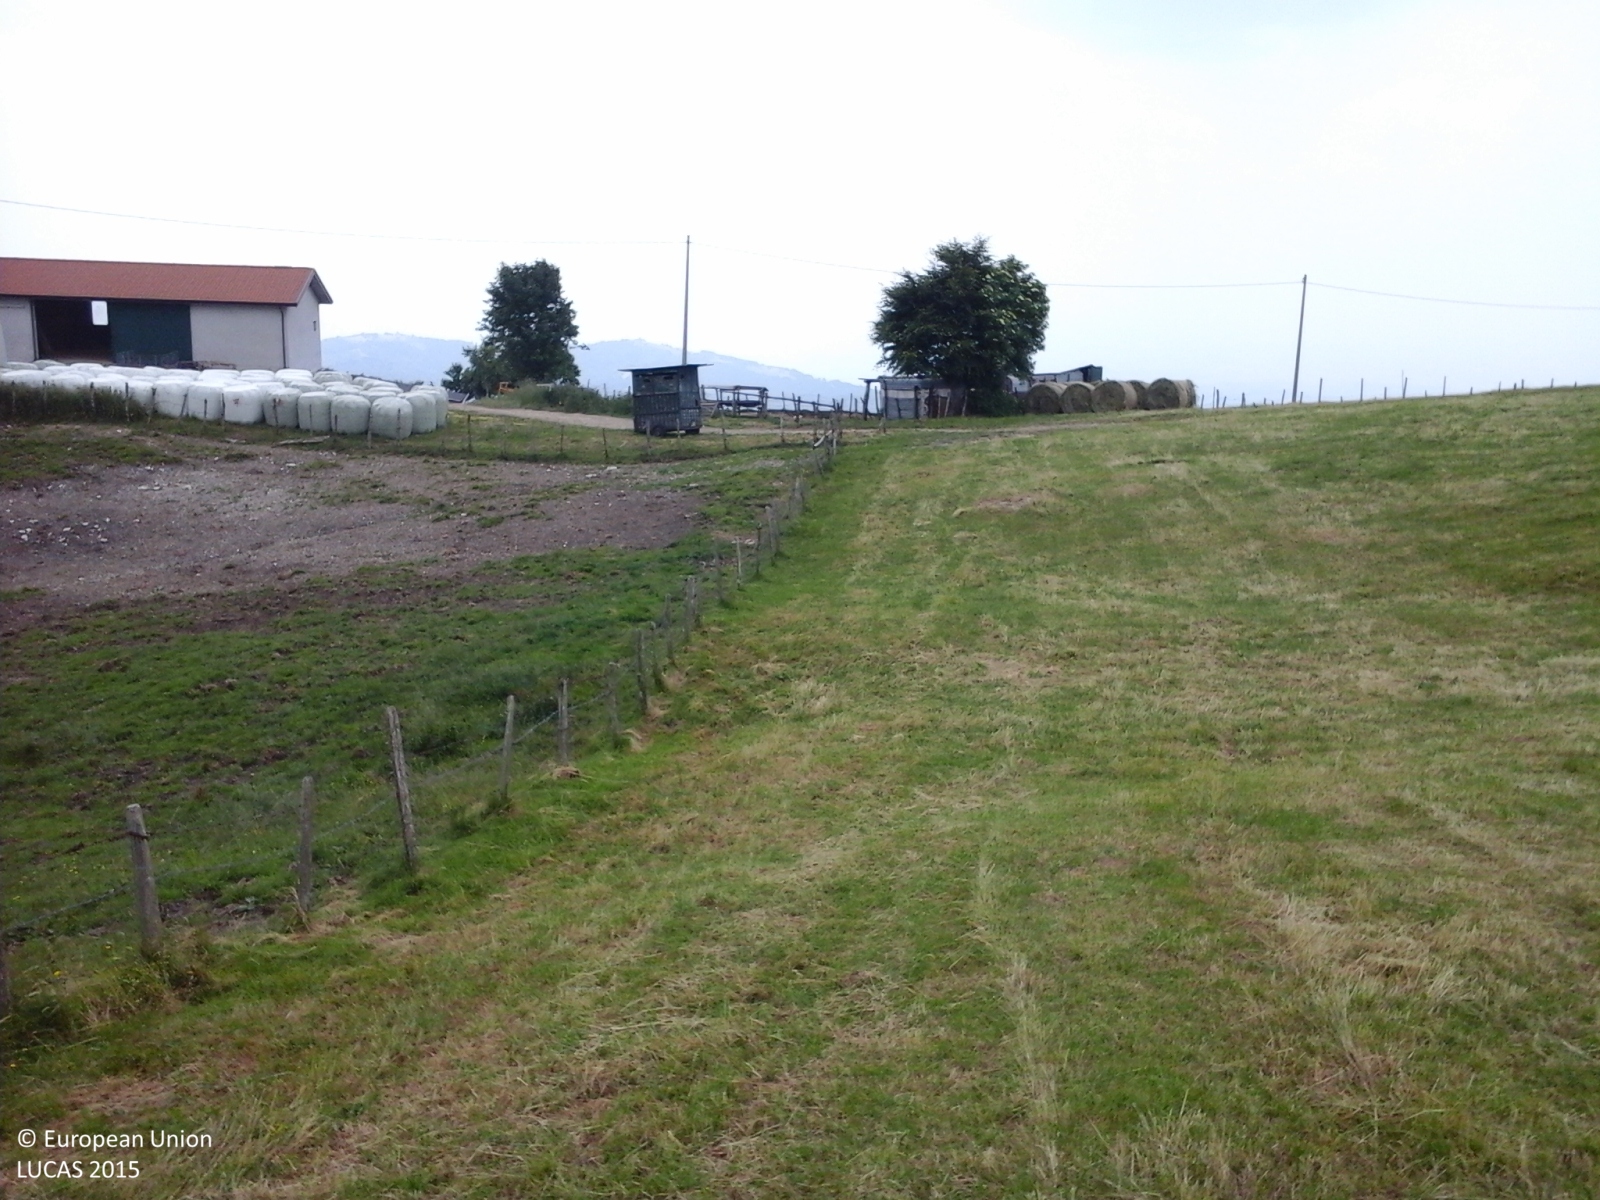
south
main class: Grassland
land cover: Grassland without tree/shrub cover
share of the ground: > 75 %
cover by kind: herbaceous plants 100 %
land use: Agriculture (excluding fallow land and kitchen gardens)
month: June
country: IT
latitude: 45.8166
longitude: 11.6064
